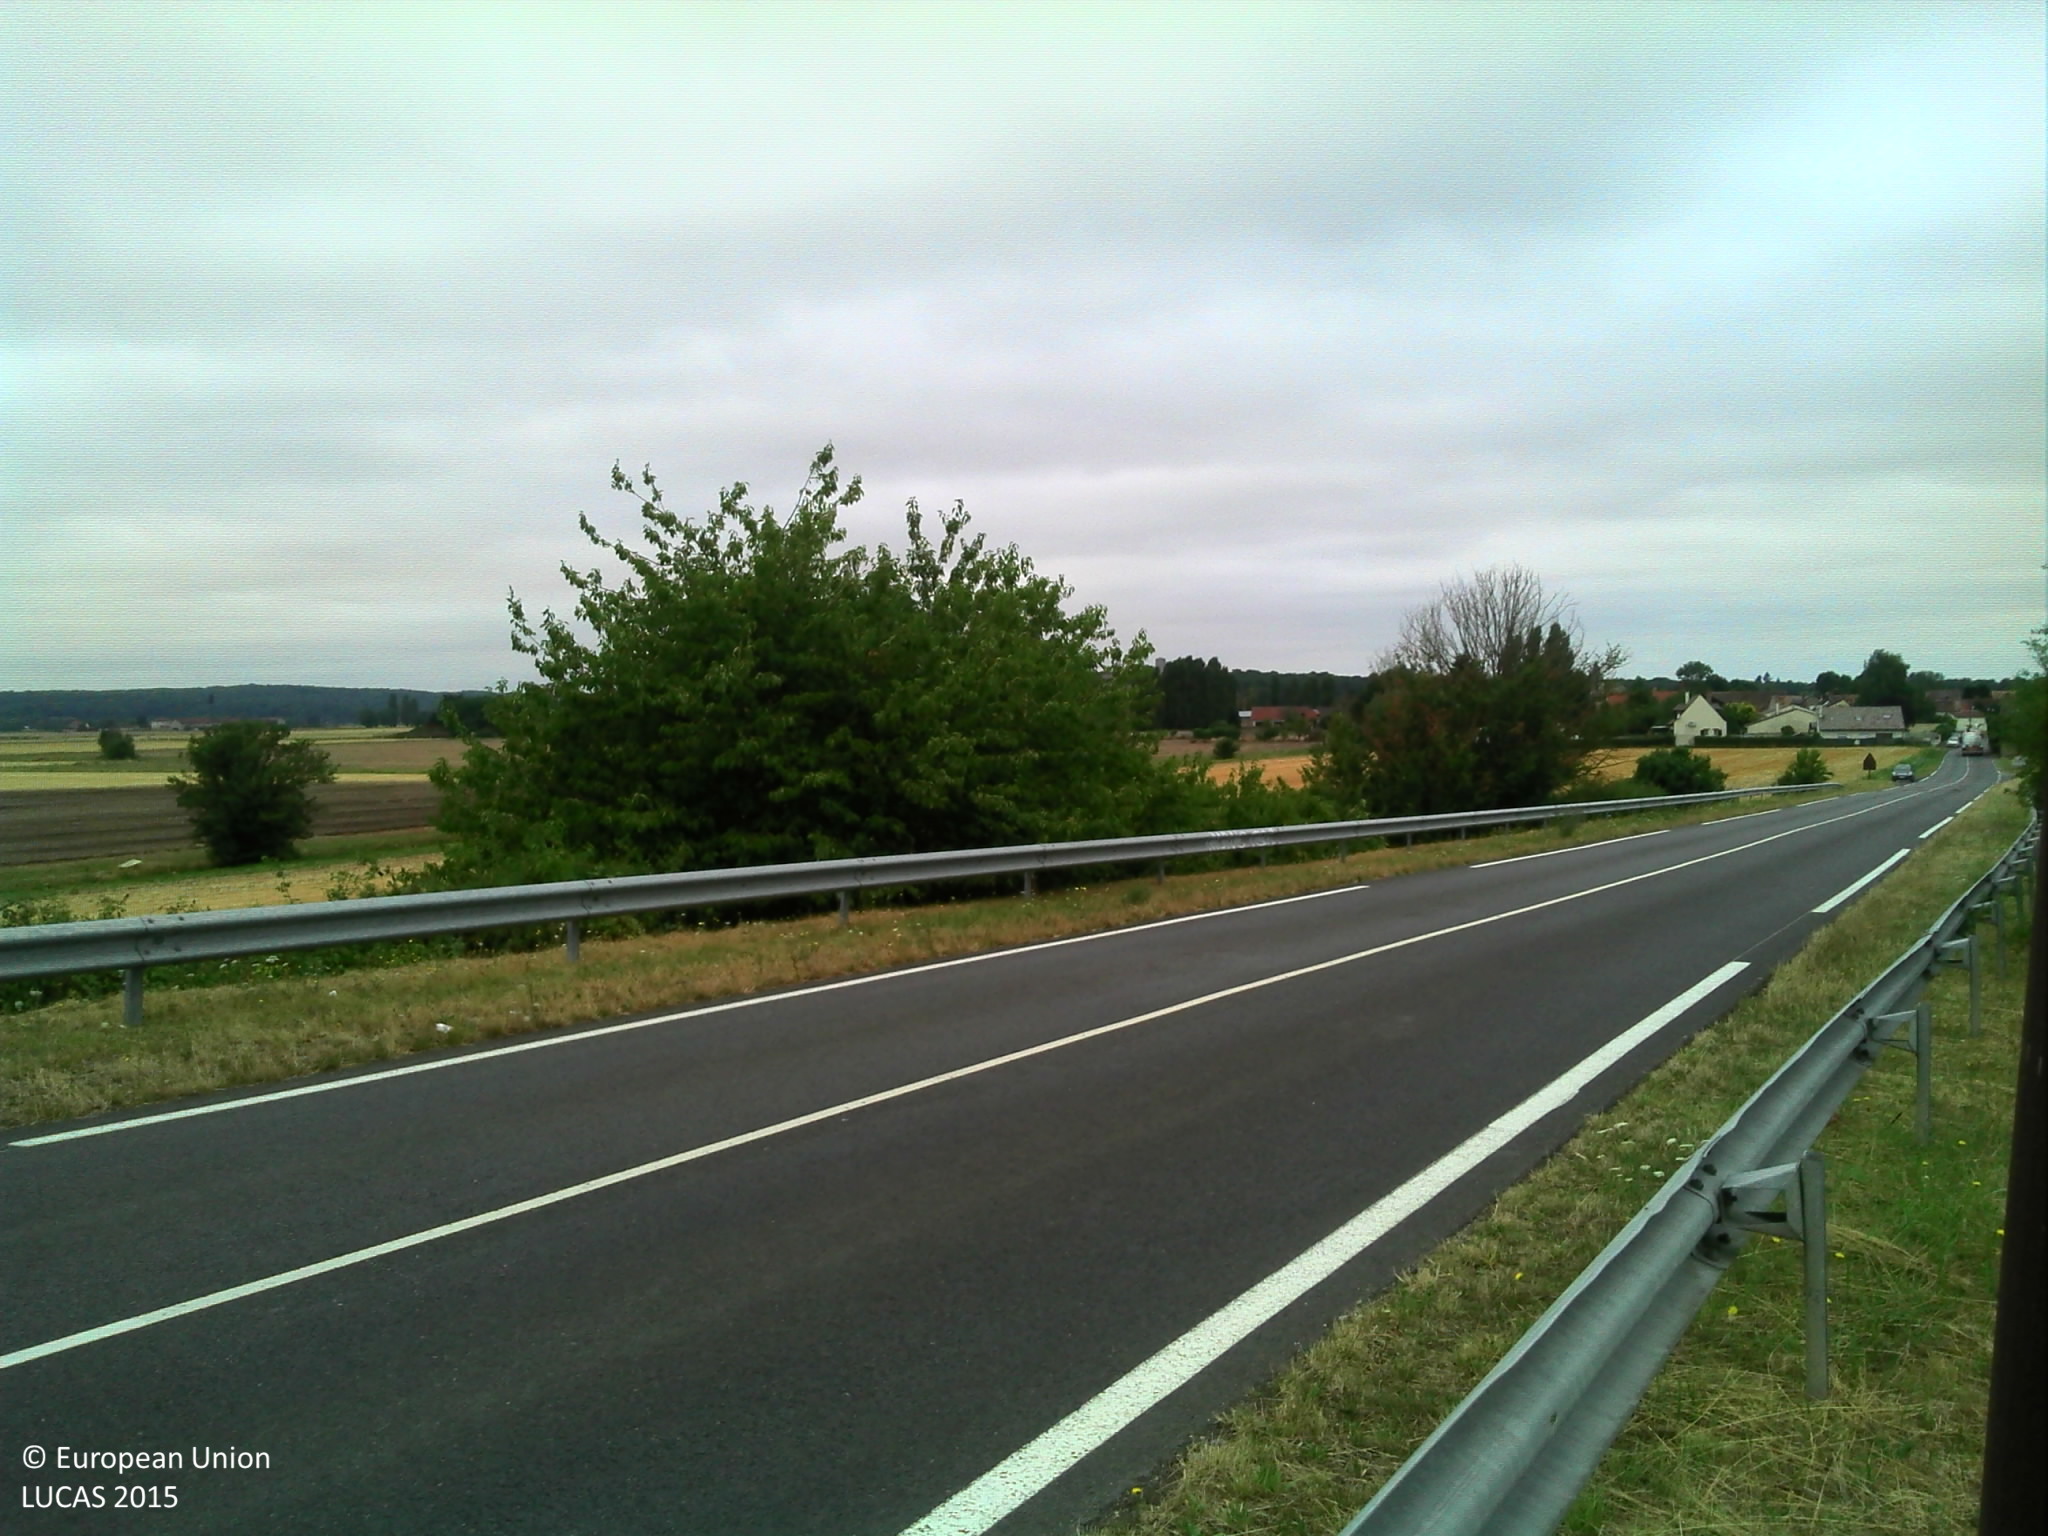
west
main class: Grassland
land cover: Grassland without tree/shrub cover
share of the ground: > 75 %
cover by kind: herbaceous plants 70 %, consolidated bare surface 10 %, unconsolidated bare surface 10 %, shrubs 5 %, lichens and mosses 5 %
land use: Road transport
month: July
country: FR
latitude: 48.5281
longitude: 2.5010
